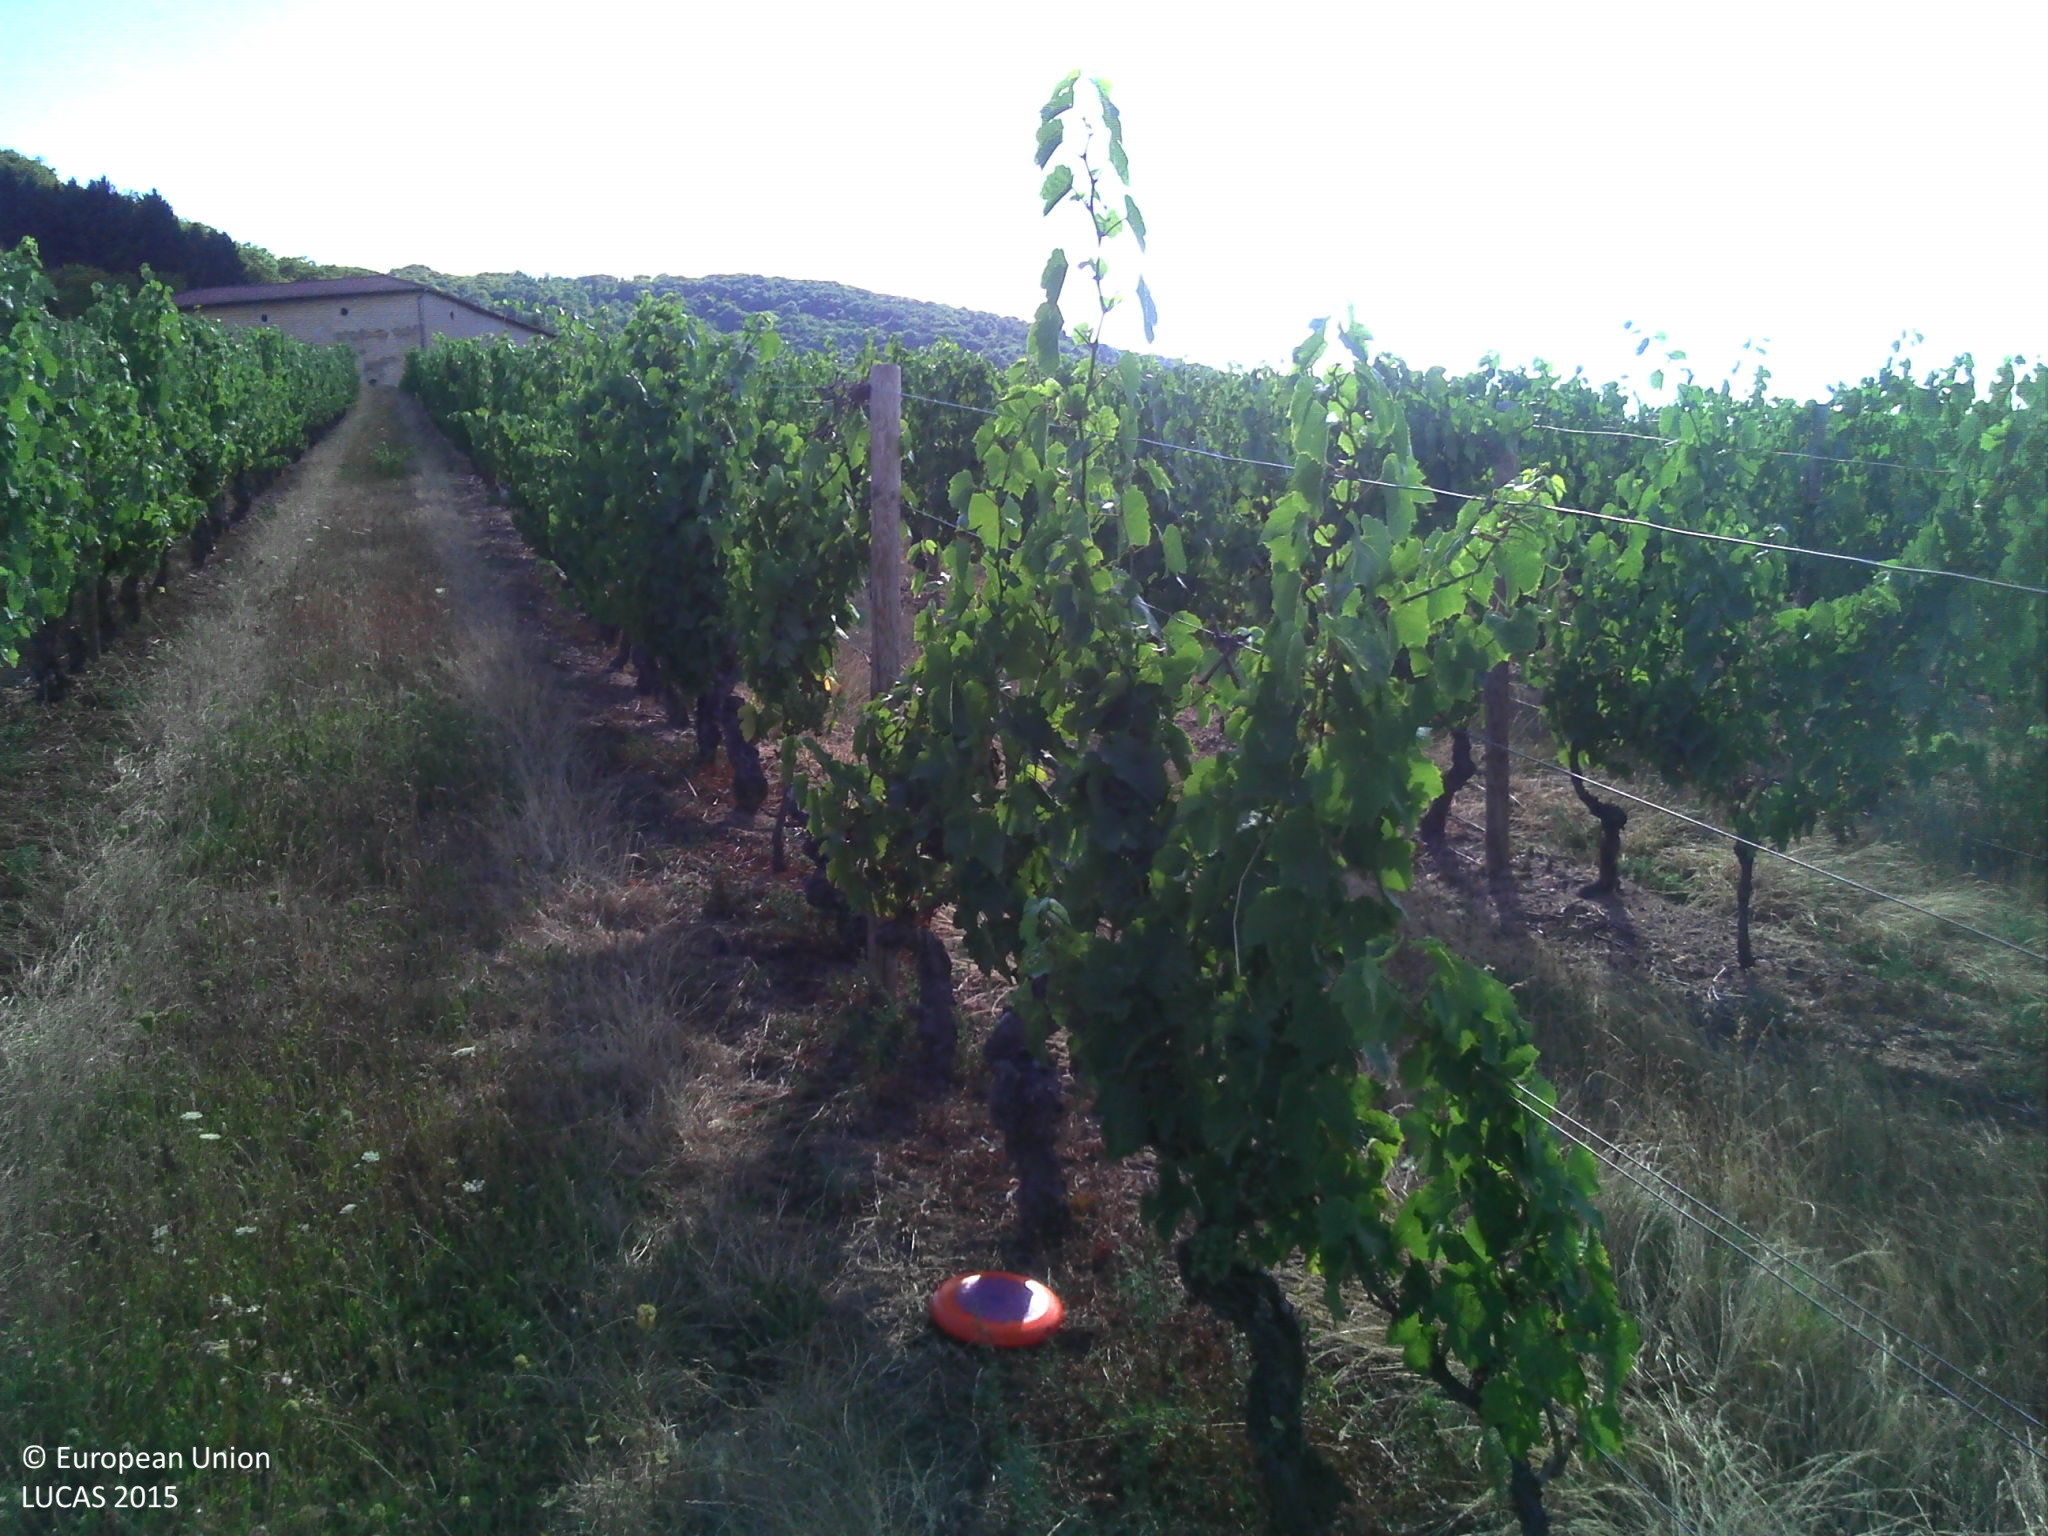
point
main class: Cropland
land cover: Vineyards
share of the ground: > 75 %
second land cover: Grassland without tree/shrub cover
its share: 10 - 25 %
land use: Agriculture (excluding fallow land and kitchen gardens)
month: July
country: FR
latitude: 45.8502
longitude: 4.5299
